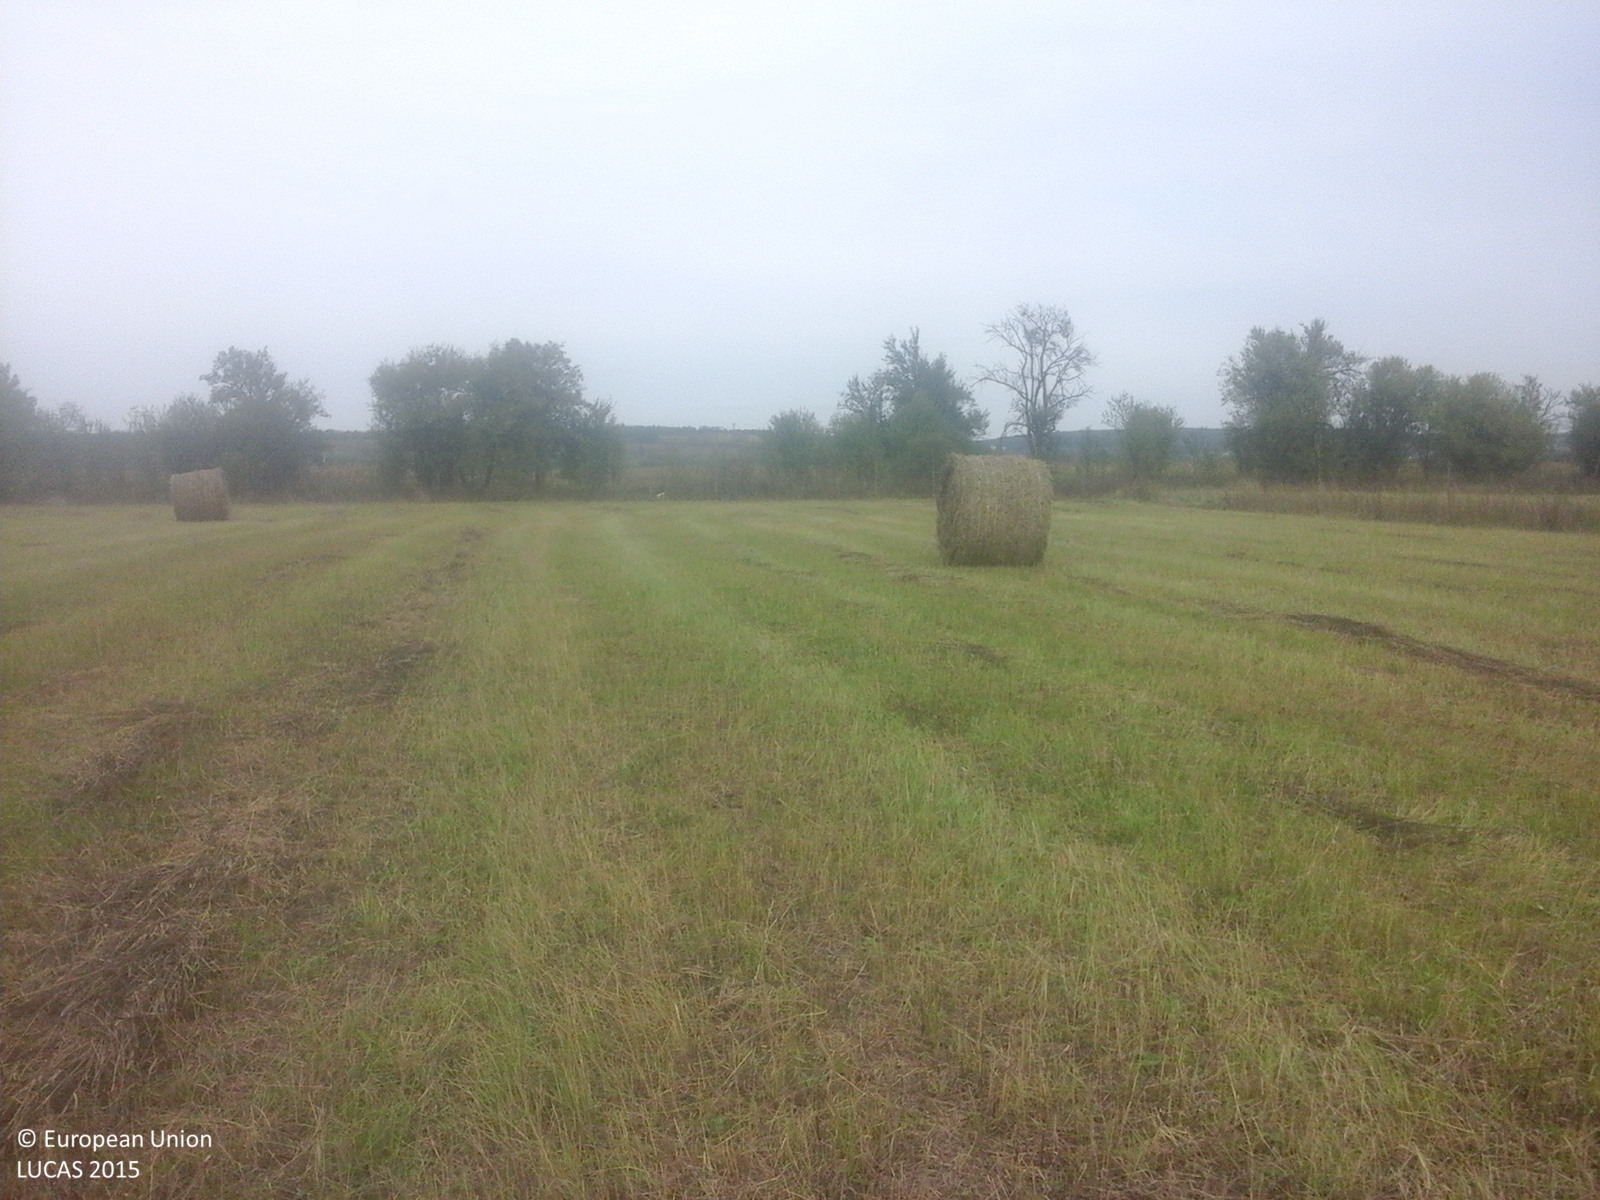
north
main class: Grassland
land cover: Grassland without tree/shrub cover
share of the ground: > 75 %
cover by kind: herbaceous plants 100 %
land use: Agriculture (excluding fallow land and kitchen gardens)
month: September
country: RO
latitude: 45.8398
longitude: 22.1323
